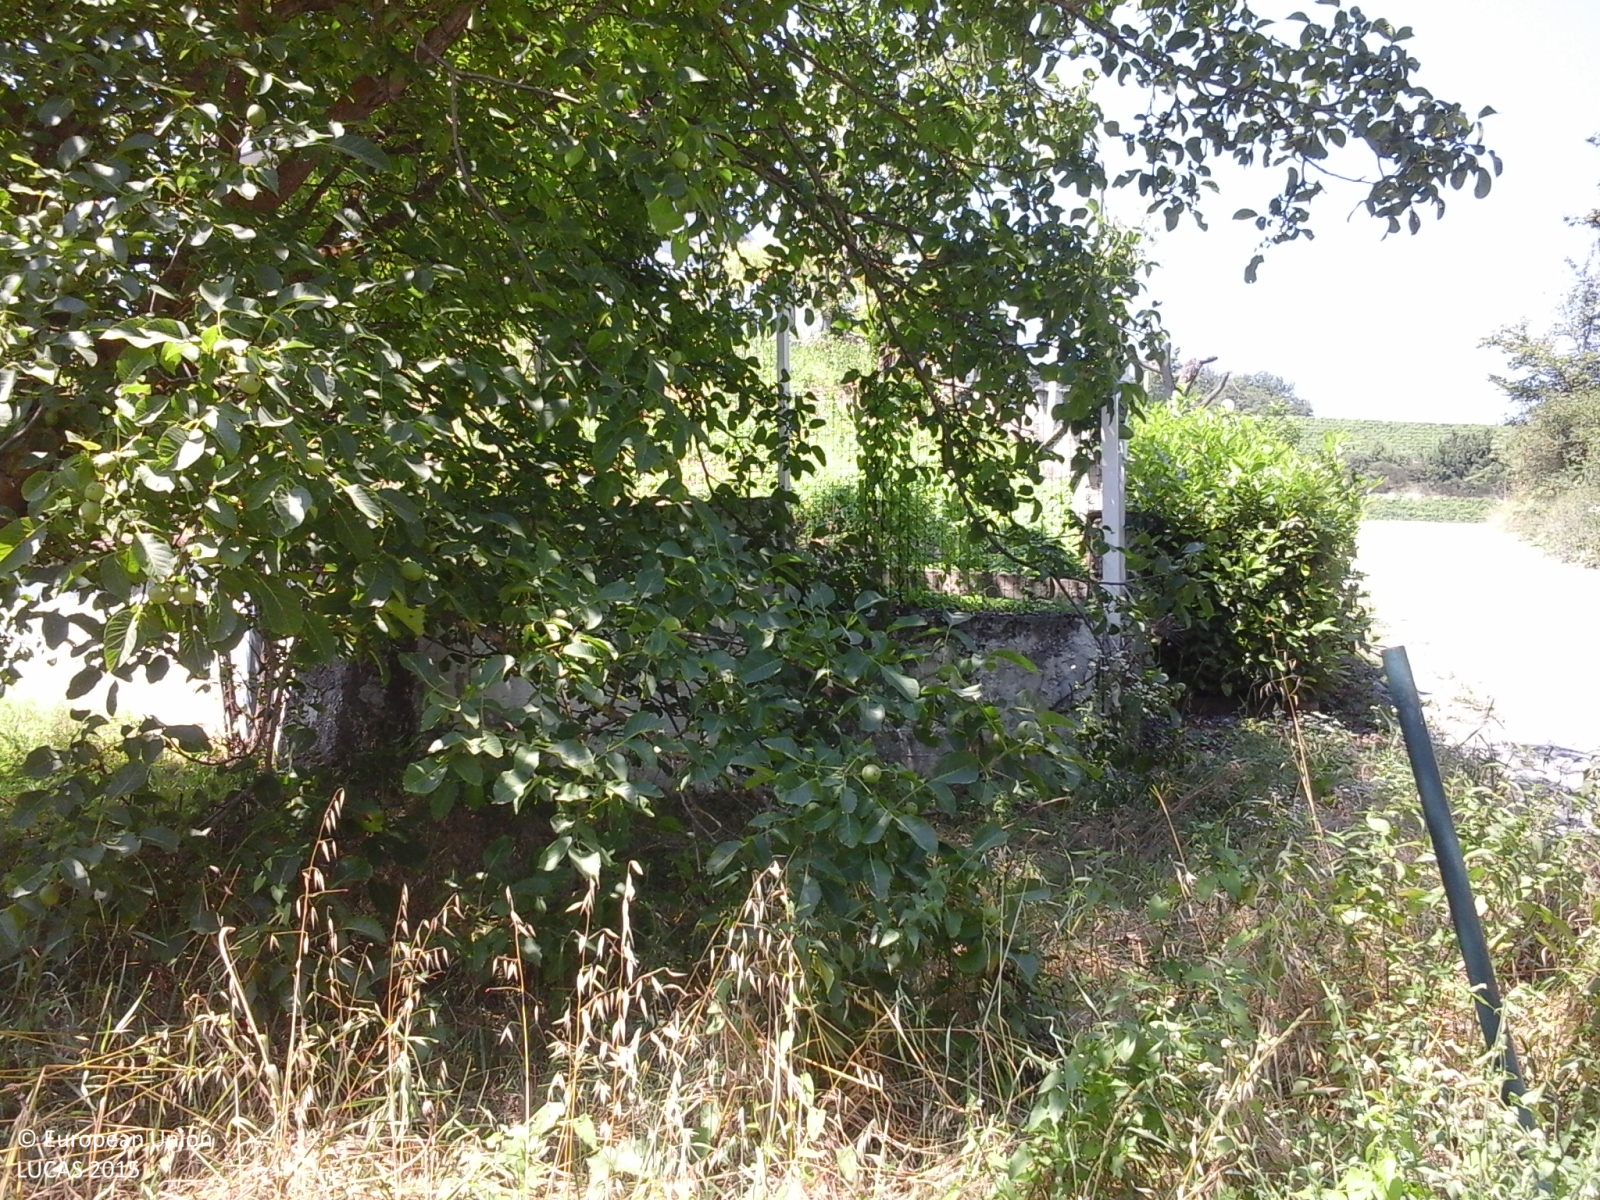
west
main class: Grassland
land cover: Grassland with sparse tree/shrub cover
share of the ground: > 75 %
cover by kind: herbaceous plants 95 %, broadleaved forest trees 5 %
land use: Agriculture (excluding fallow land and kitchen gardens)
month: June
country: IT
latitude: 44.6683
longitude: 8.8042
